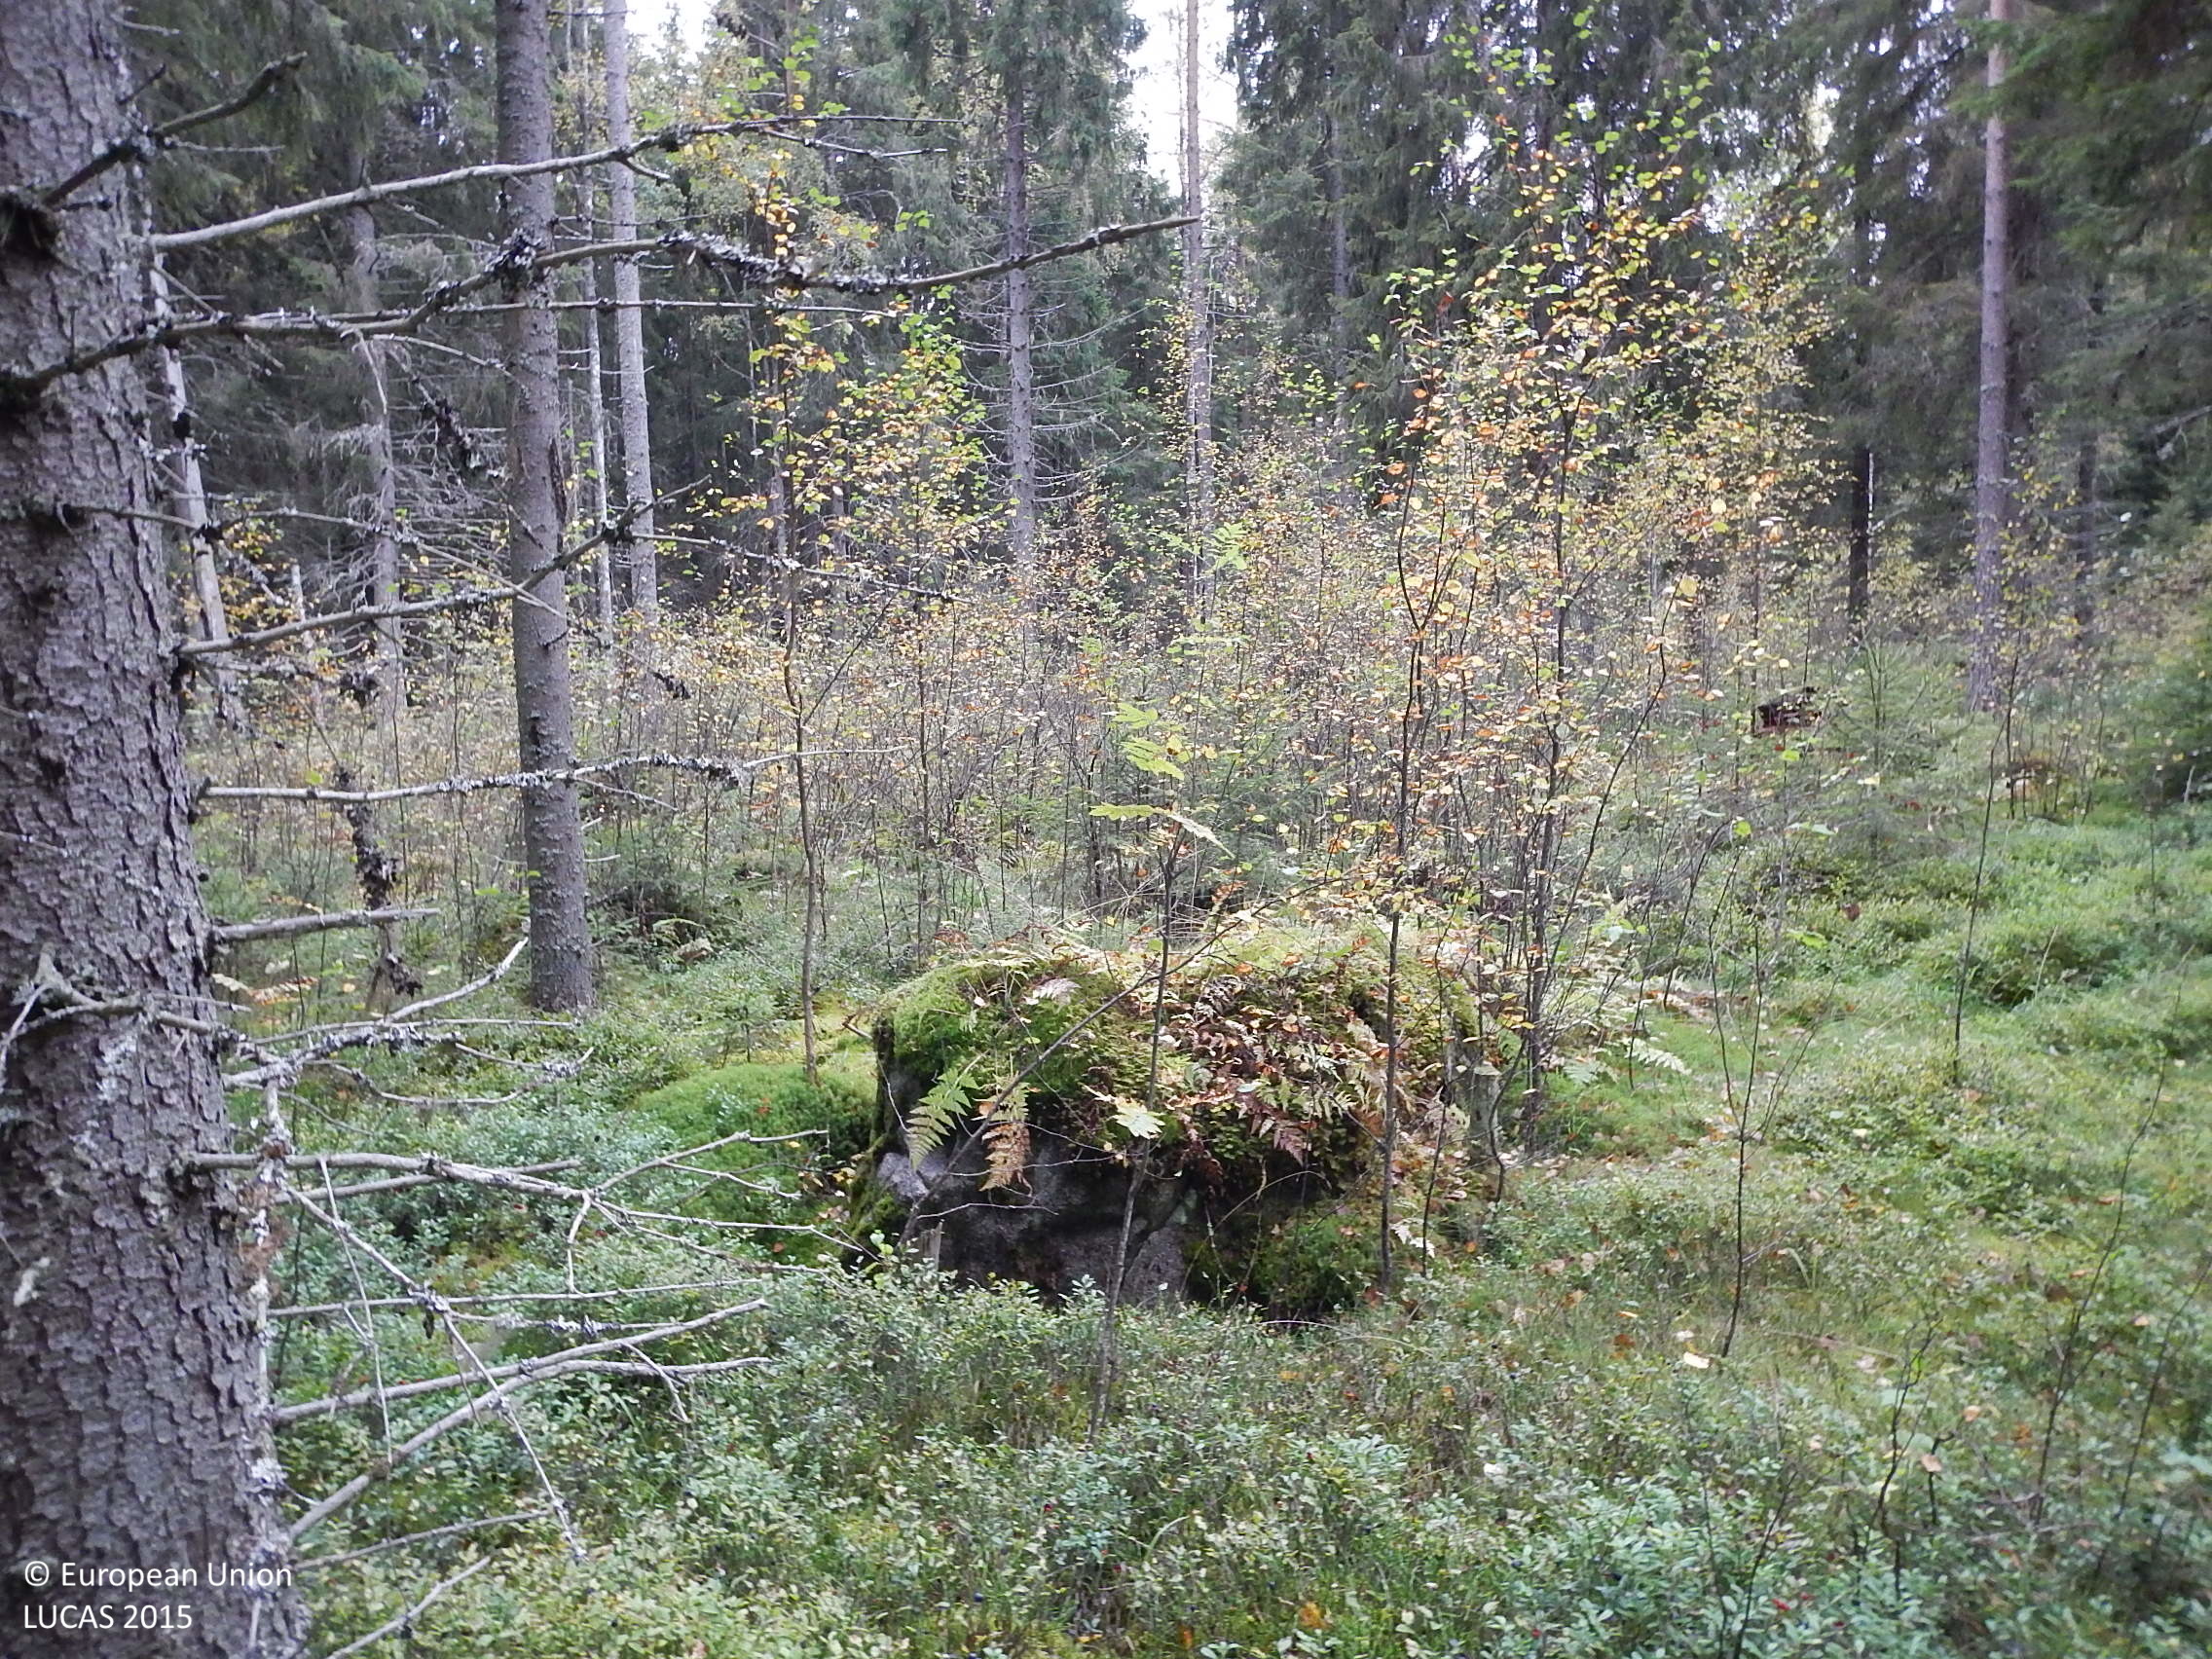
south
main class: Woodland
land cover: Spruce dominated coniferous woodland
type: boreal forest
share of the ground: > 75 %
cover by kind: coniferous forest trees 80 %, shrubs 10 %, lichens and mosses 10 %
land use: Forestry
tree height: > 5 m
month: September
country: FI
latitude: 61.9630
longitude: 22.9004
